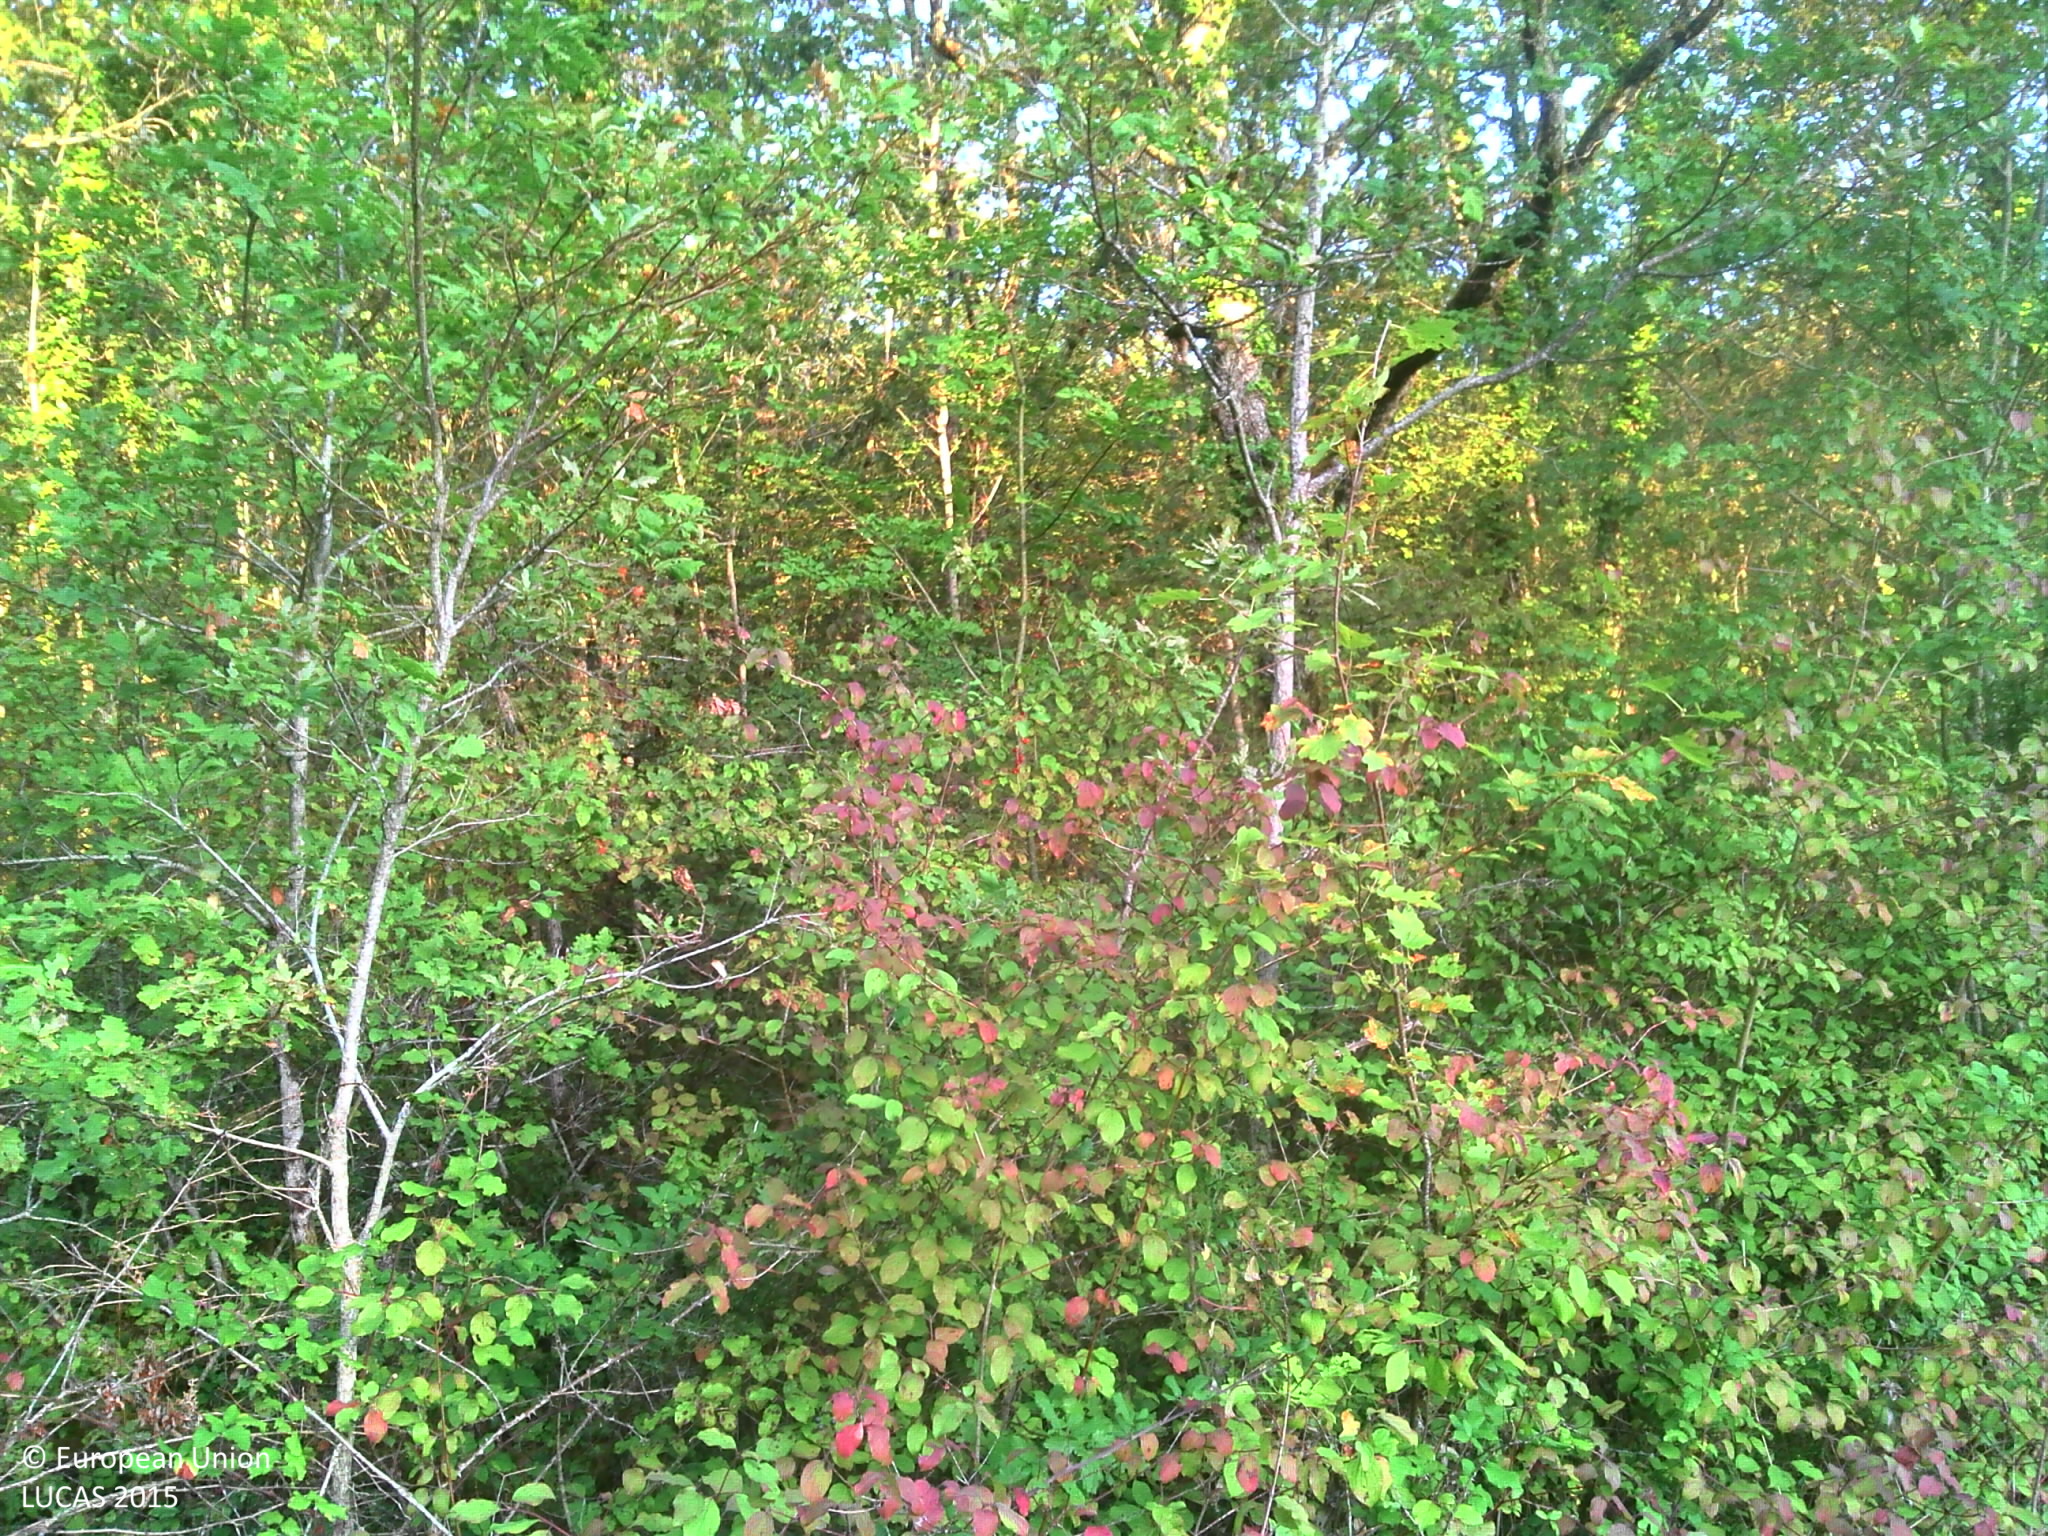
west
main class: Grassland
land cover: Grassland without tree/shrub cover
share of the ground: > 75 %
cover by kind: herbaceous plants 100 %
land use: Agriculture (excluding fallow land and kitchen gardens)
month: August
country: FR
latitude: 45.0050
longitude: 1.5848
